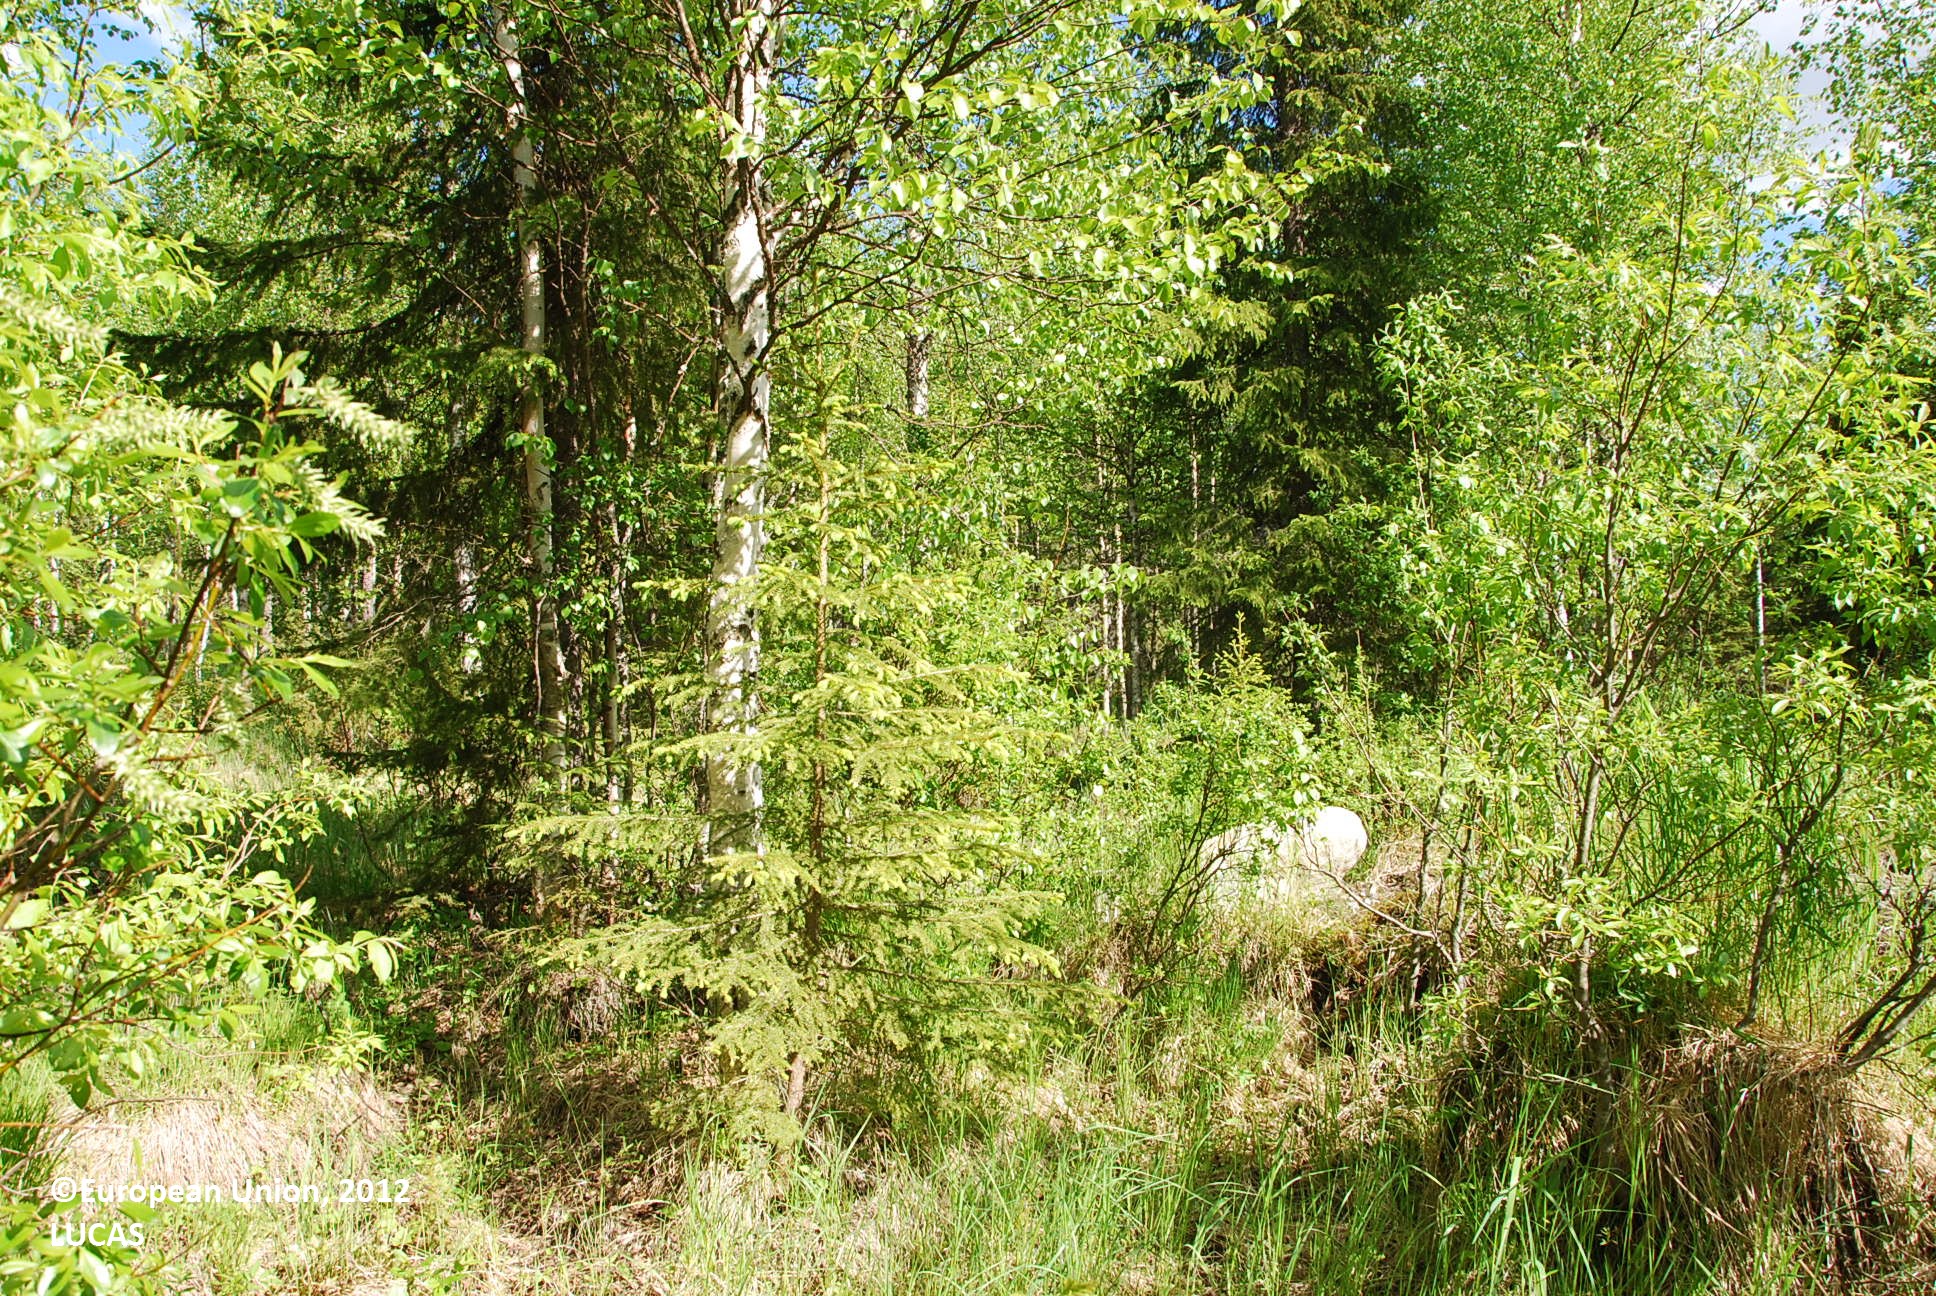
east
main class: Woodland
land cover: Broadleaved woodland
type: boreal forest
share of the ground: > 75 %
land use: Forestry
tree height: > 5 m
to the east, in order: Broadleaved woodland; Spruce dominated mixed woodland; Ditches and canals; Spruce dominated mixed woodland; Other mixed woodland; Ditches and canals; Other mixed woodland; Ditches and canals; Grassland with sparse tree/shrub cover
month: June
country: FI
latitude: 66.3735
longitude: 27.1679
